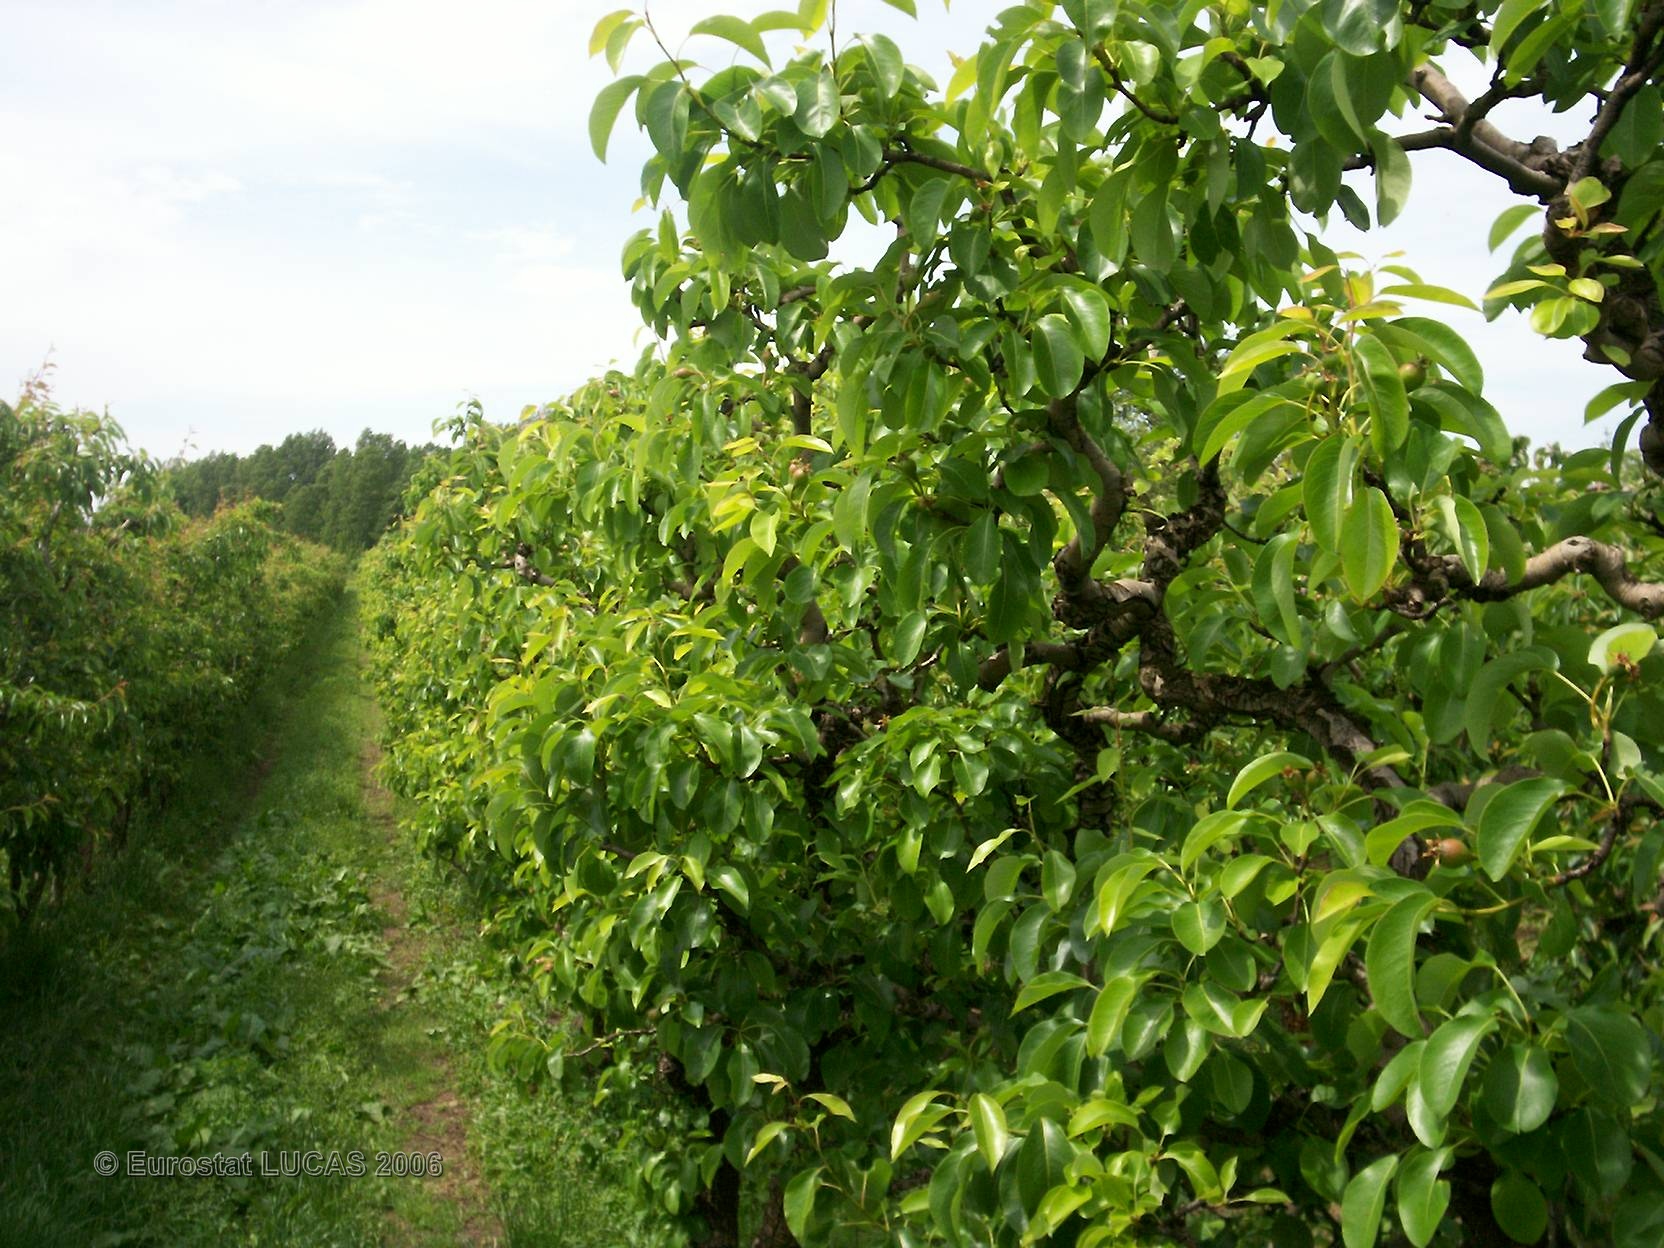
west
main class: Cropland
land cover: Pear fruit
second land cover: Grassland with sparse tree/shrub cover
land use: Agriculture (excluding fallow land and kitchen gardens)
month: May
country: FR
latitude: 45.6654
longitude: 4.8055
